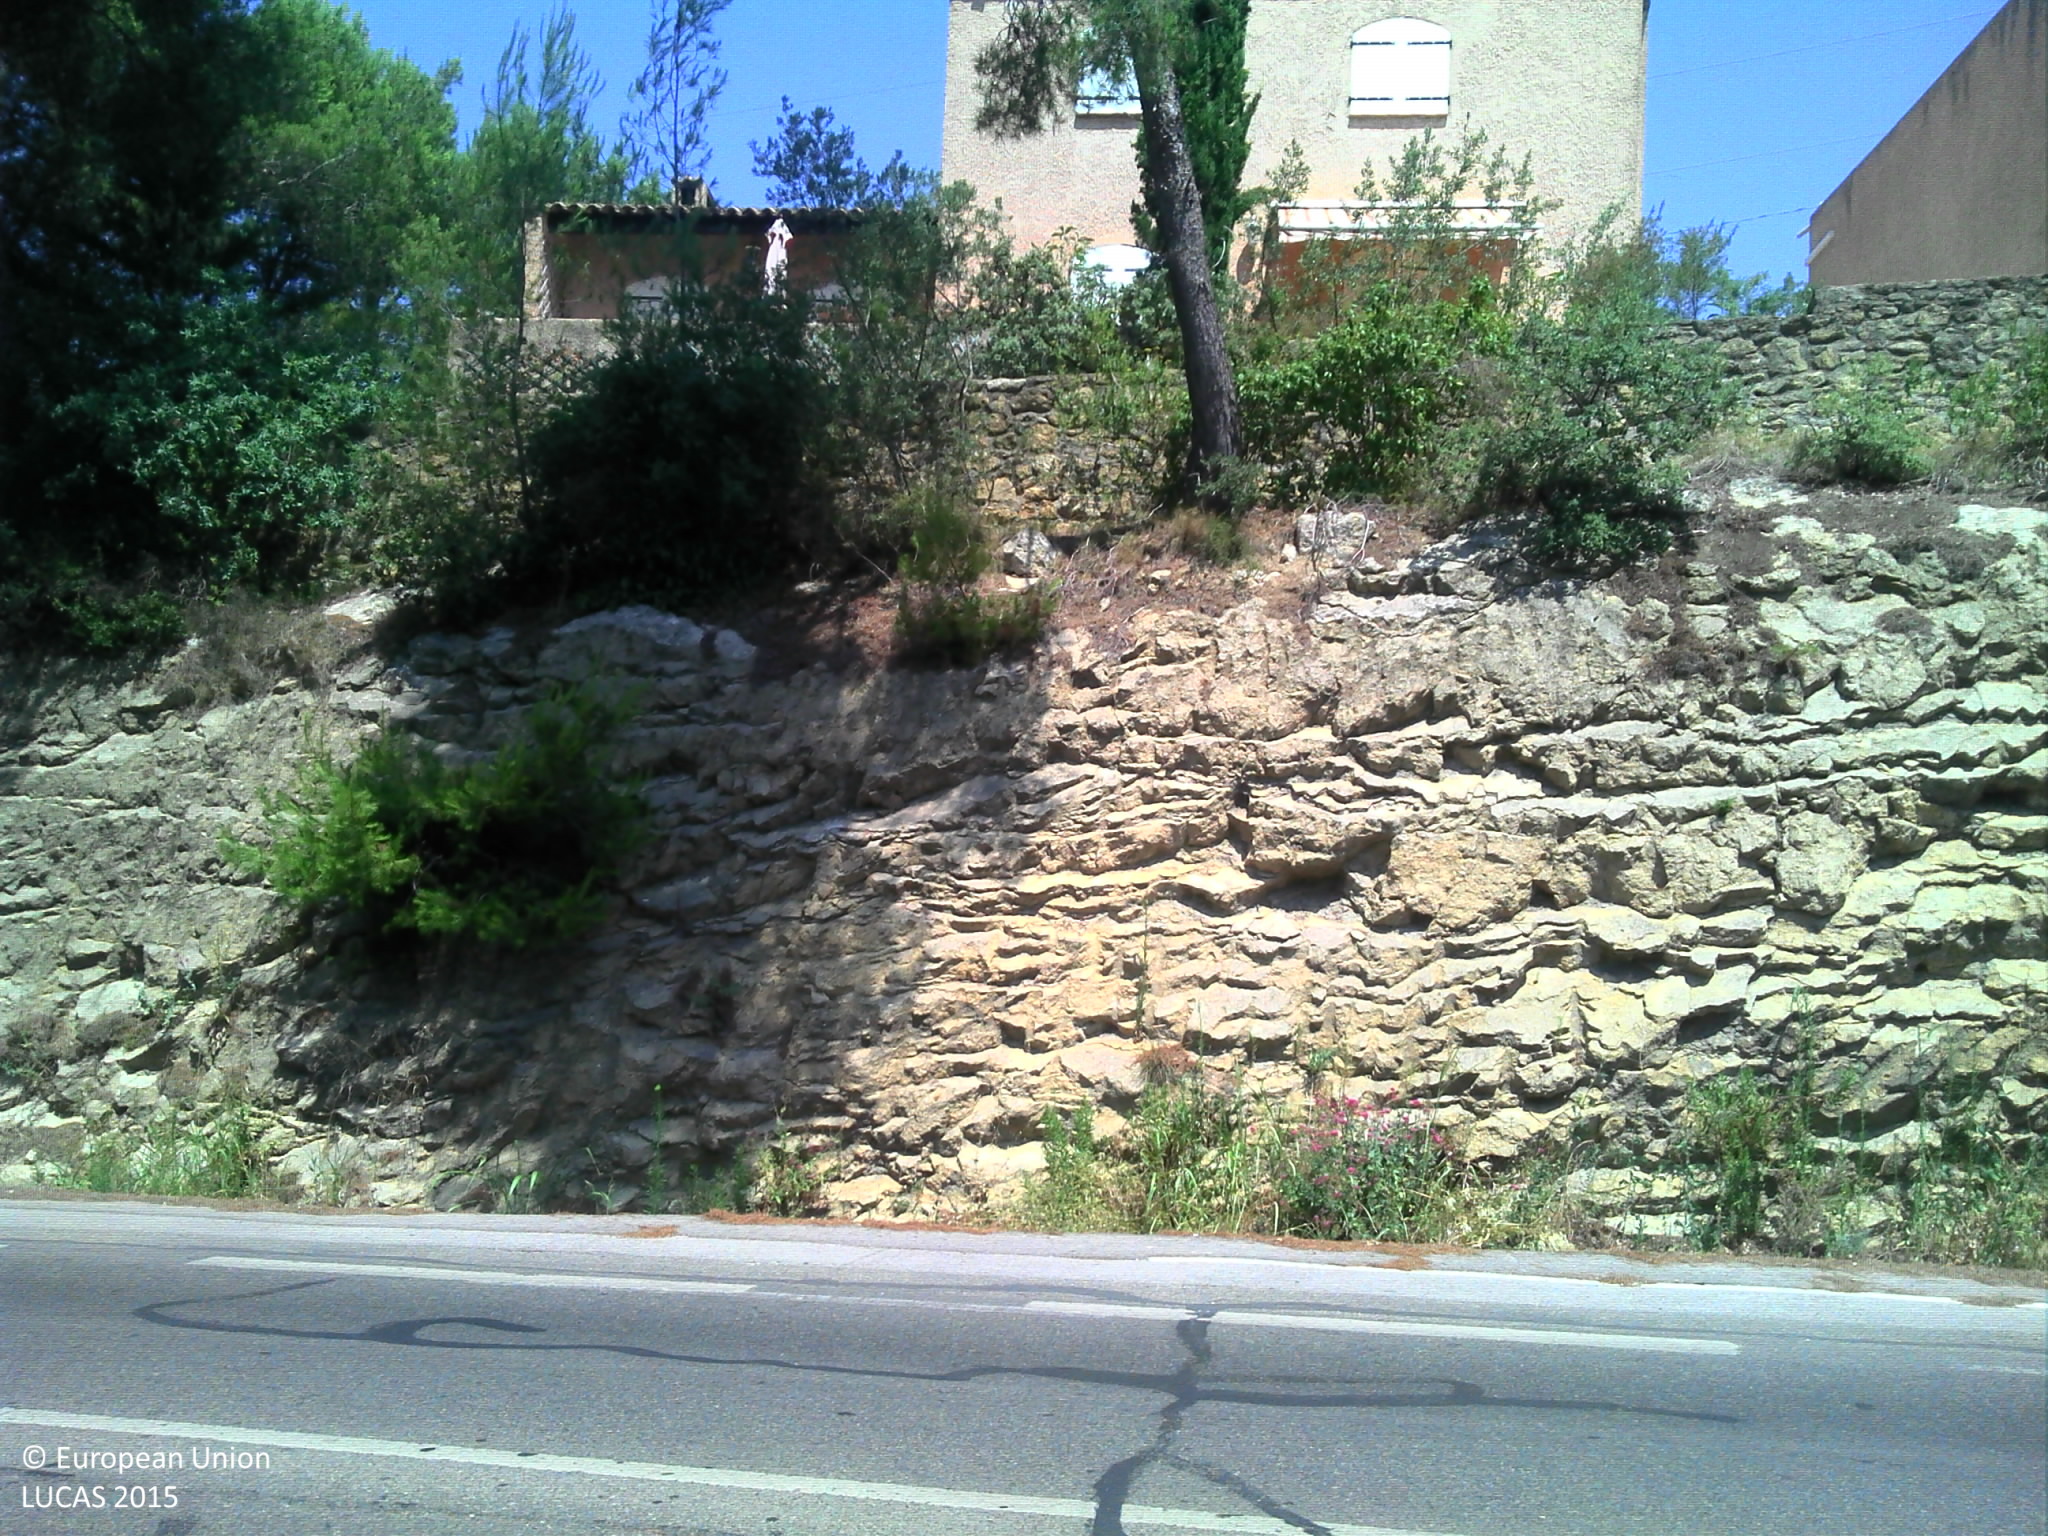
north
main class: Woodland
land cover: Pine dominated coniferous woodland
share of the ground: 25 - 50 %
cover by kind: coniferous forest trees 20 %, shrubs 10 %, herbaceous plants 10 %
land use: Residential
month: July
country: FR
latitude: 43.6391
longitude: 5.1131
